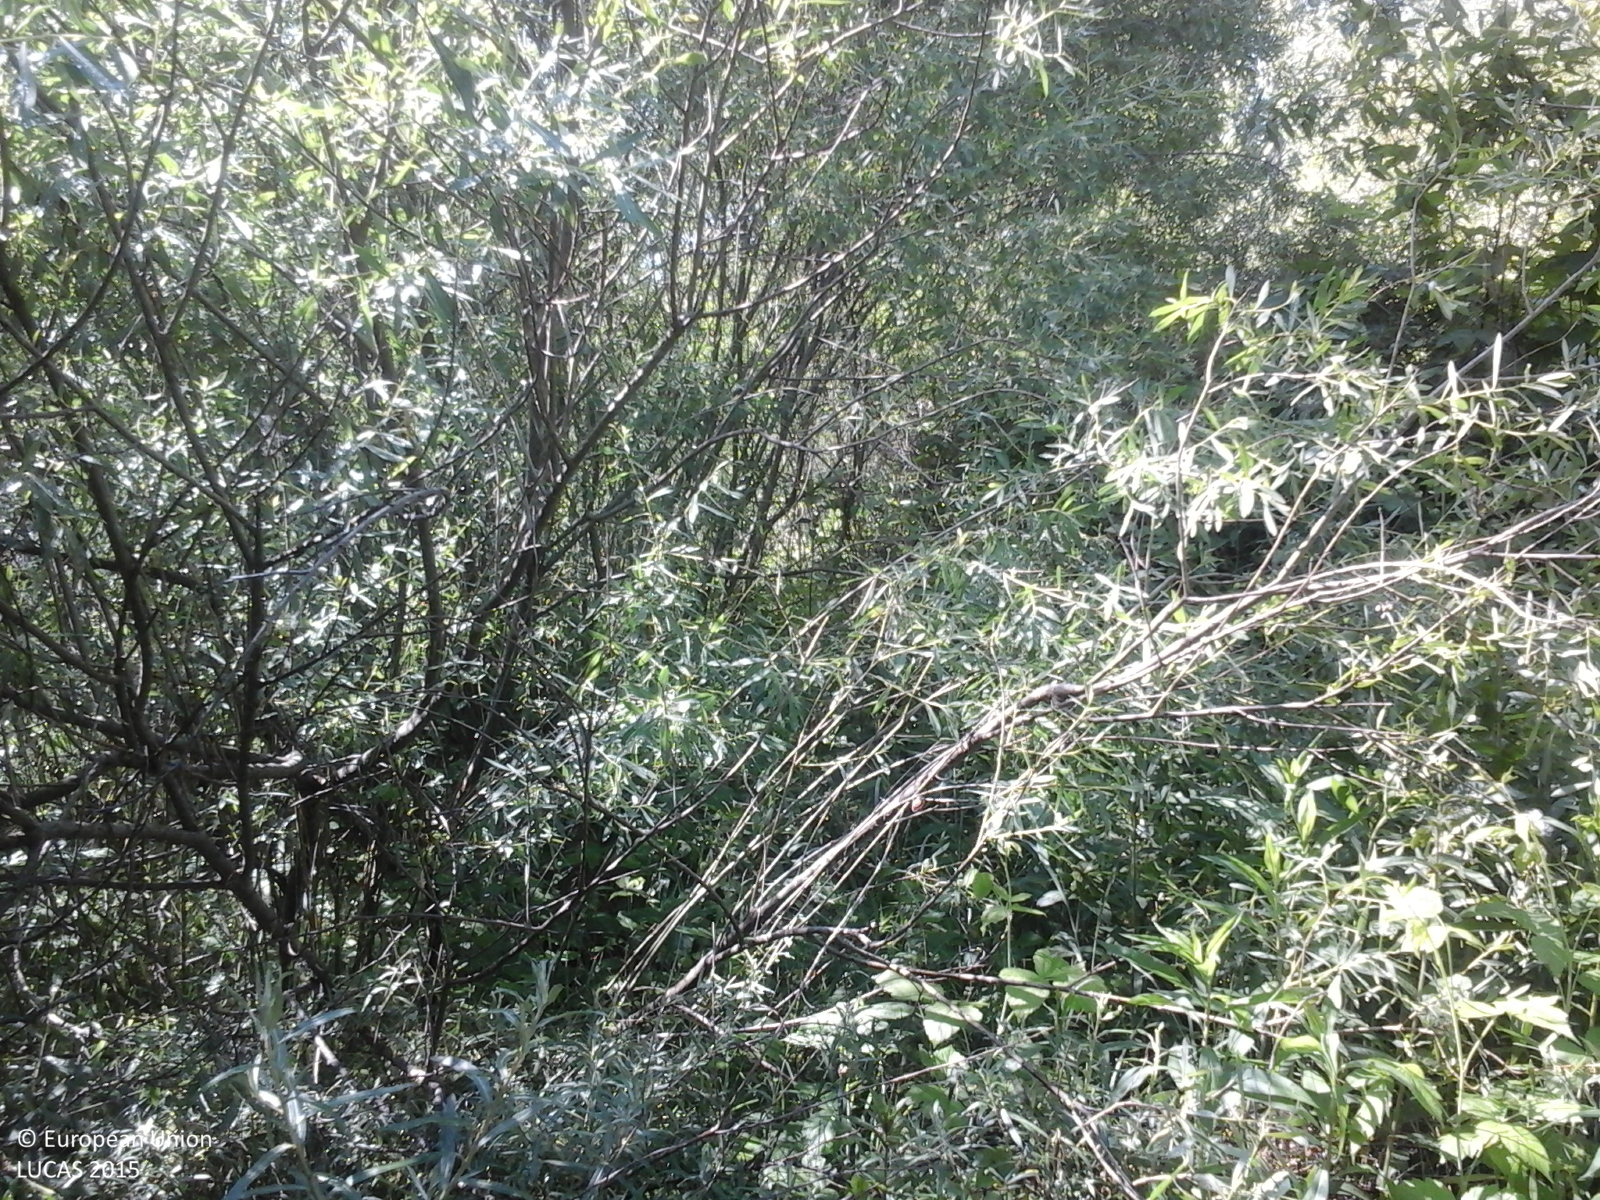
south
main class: Woodland
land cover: Broadleaved woodland
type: non-riverine alder, birch or aspen forest
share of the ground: > 75 %
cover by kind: broadleaved forest trees 100 %
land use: Forestry
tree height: > 5 m
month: June
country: RO
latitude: 46.5006
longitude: 26.6745
